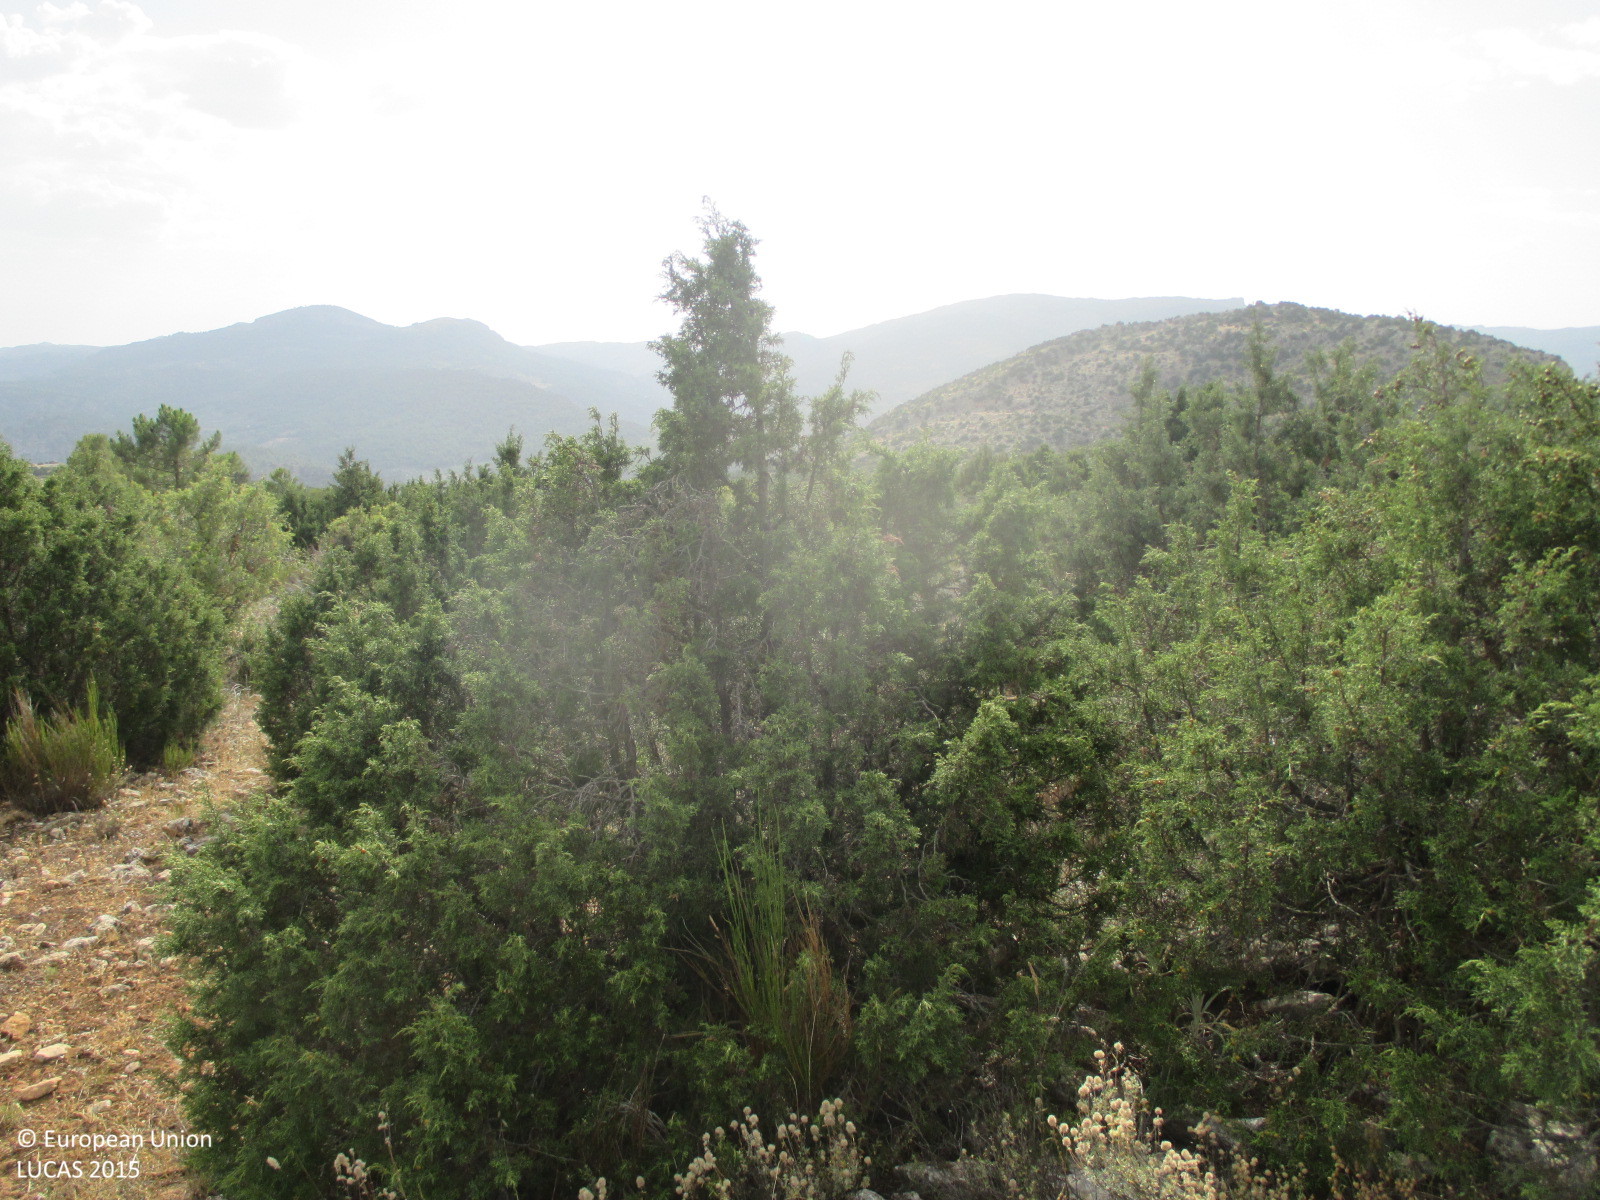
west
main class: Shrubland
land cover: Shrubland without tree cover
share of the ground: 50 - 75 %
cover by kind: shrubs 50 %, herbaceous plants 30 %, consolidated bare surface 20 %
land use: Semi-natural and natural areas not in use
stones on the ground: < 10 %
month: July
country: ES
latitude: 38.1929
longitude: -2.4285
